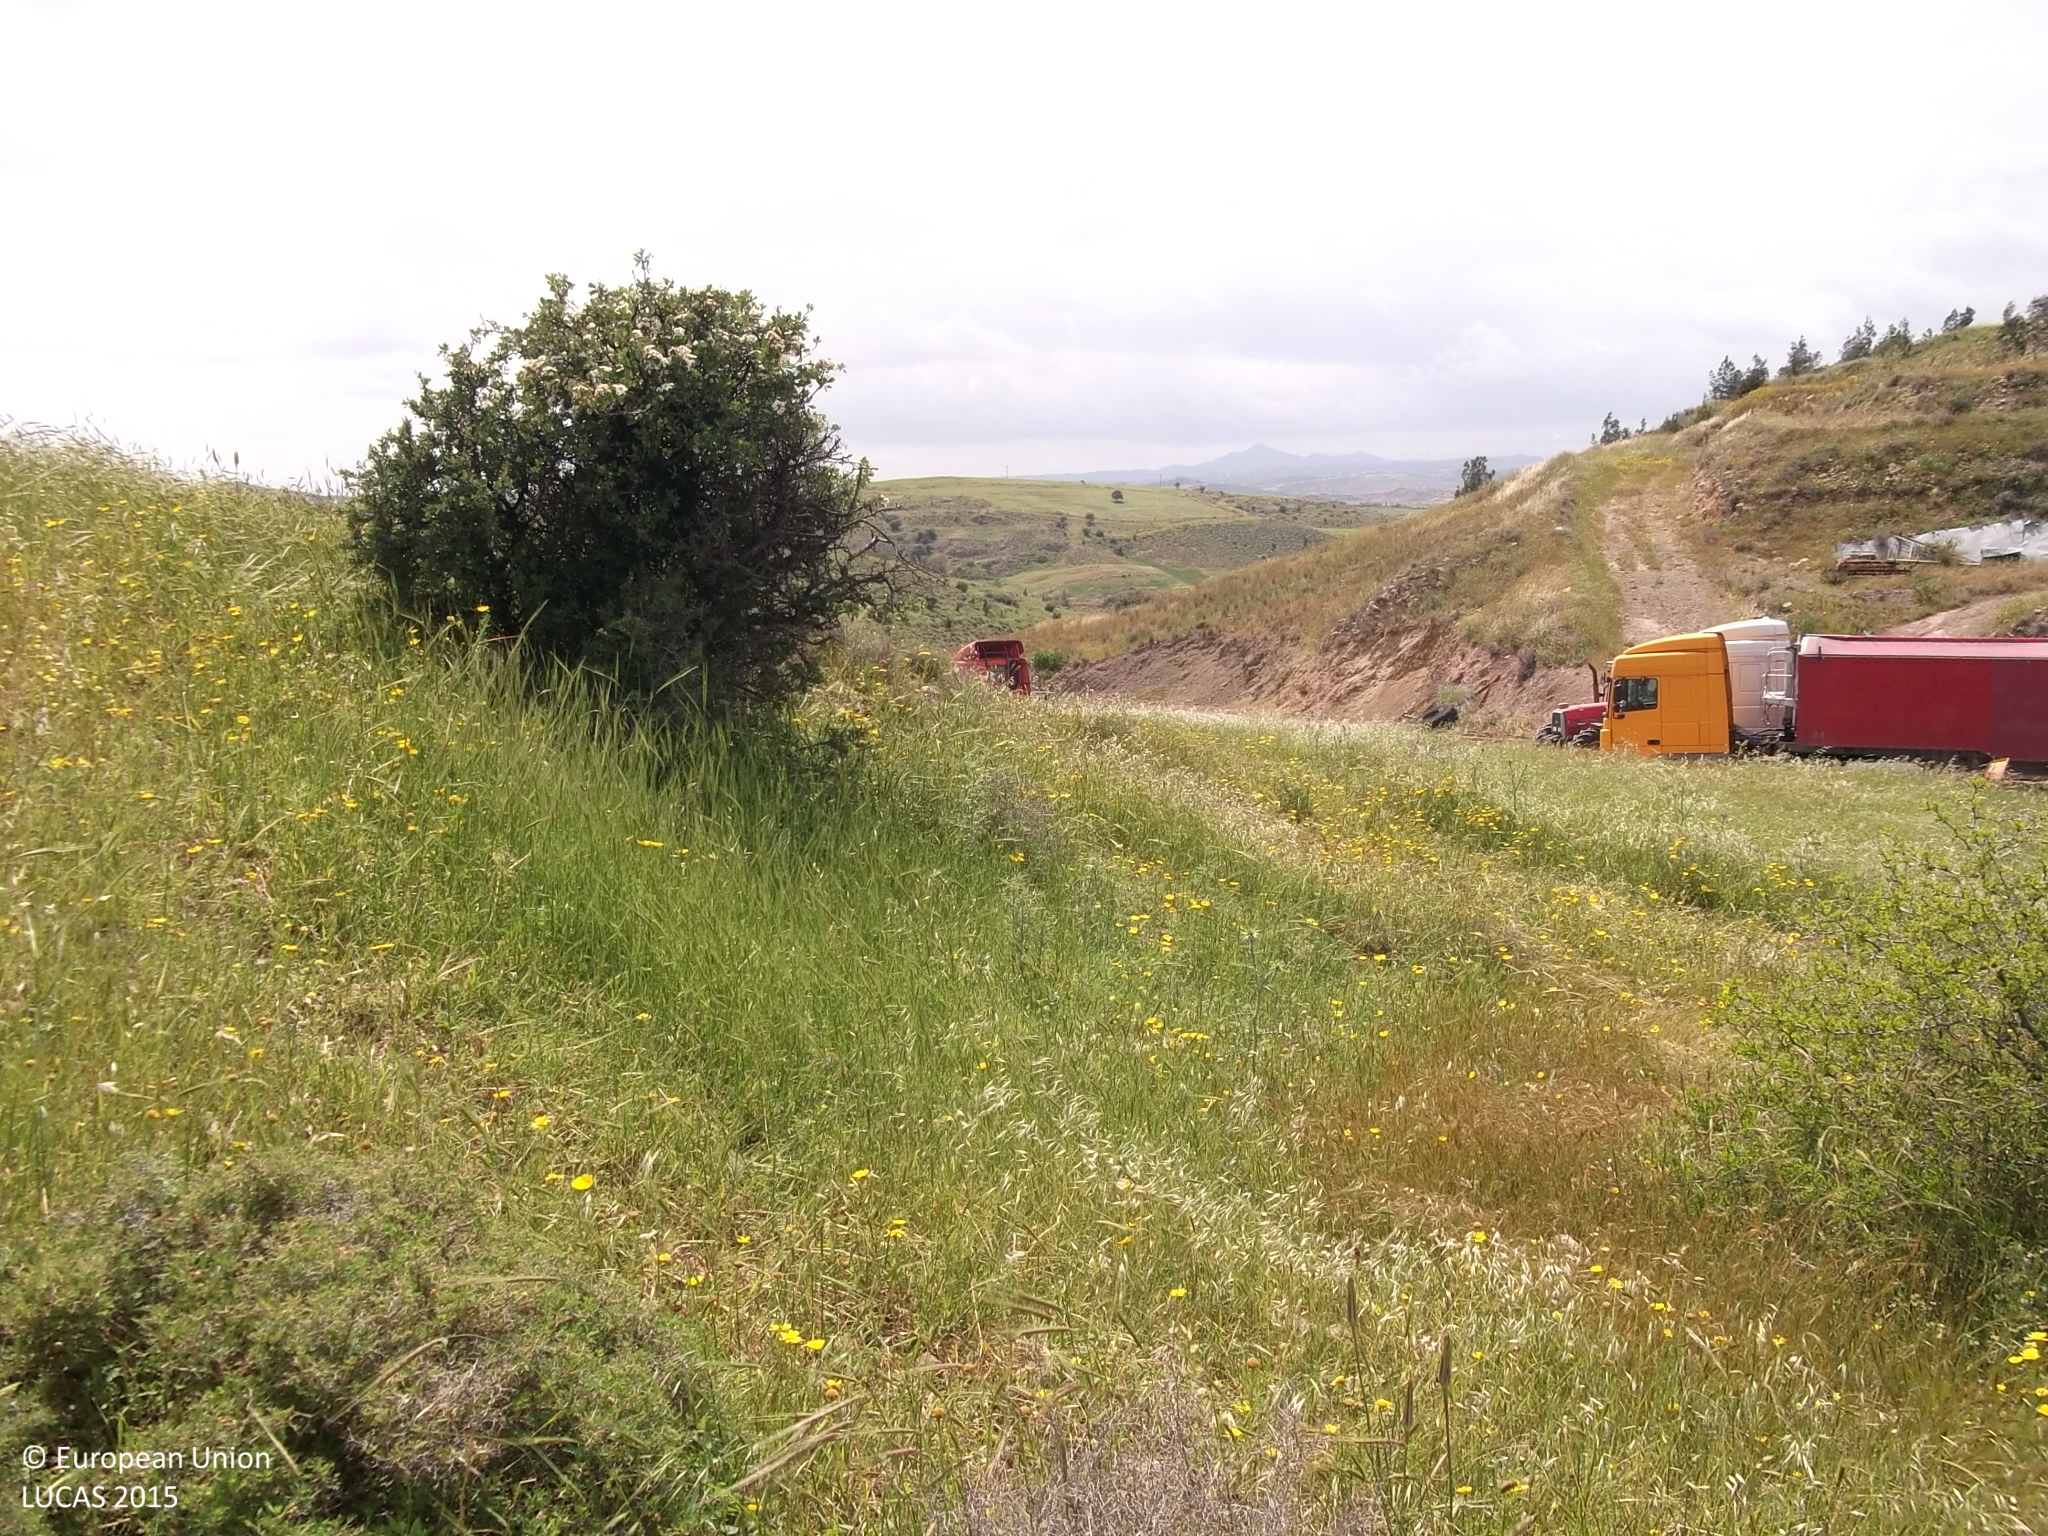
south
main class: Grassland
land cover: Grassland without tree/shrub cover
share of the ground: > 75 %
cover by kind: herbaceous plants 95 %, shrubs 5 %
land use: Semi-natural and natural areas not in use
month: April
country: CY
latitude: 35.0269
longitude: 33.6222
